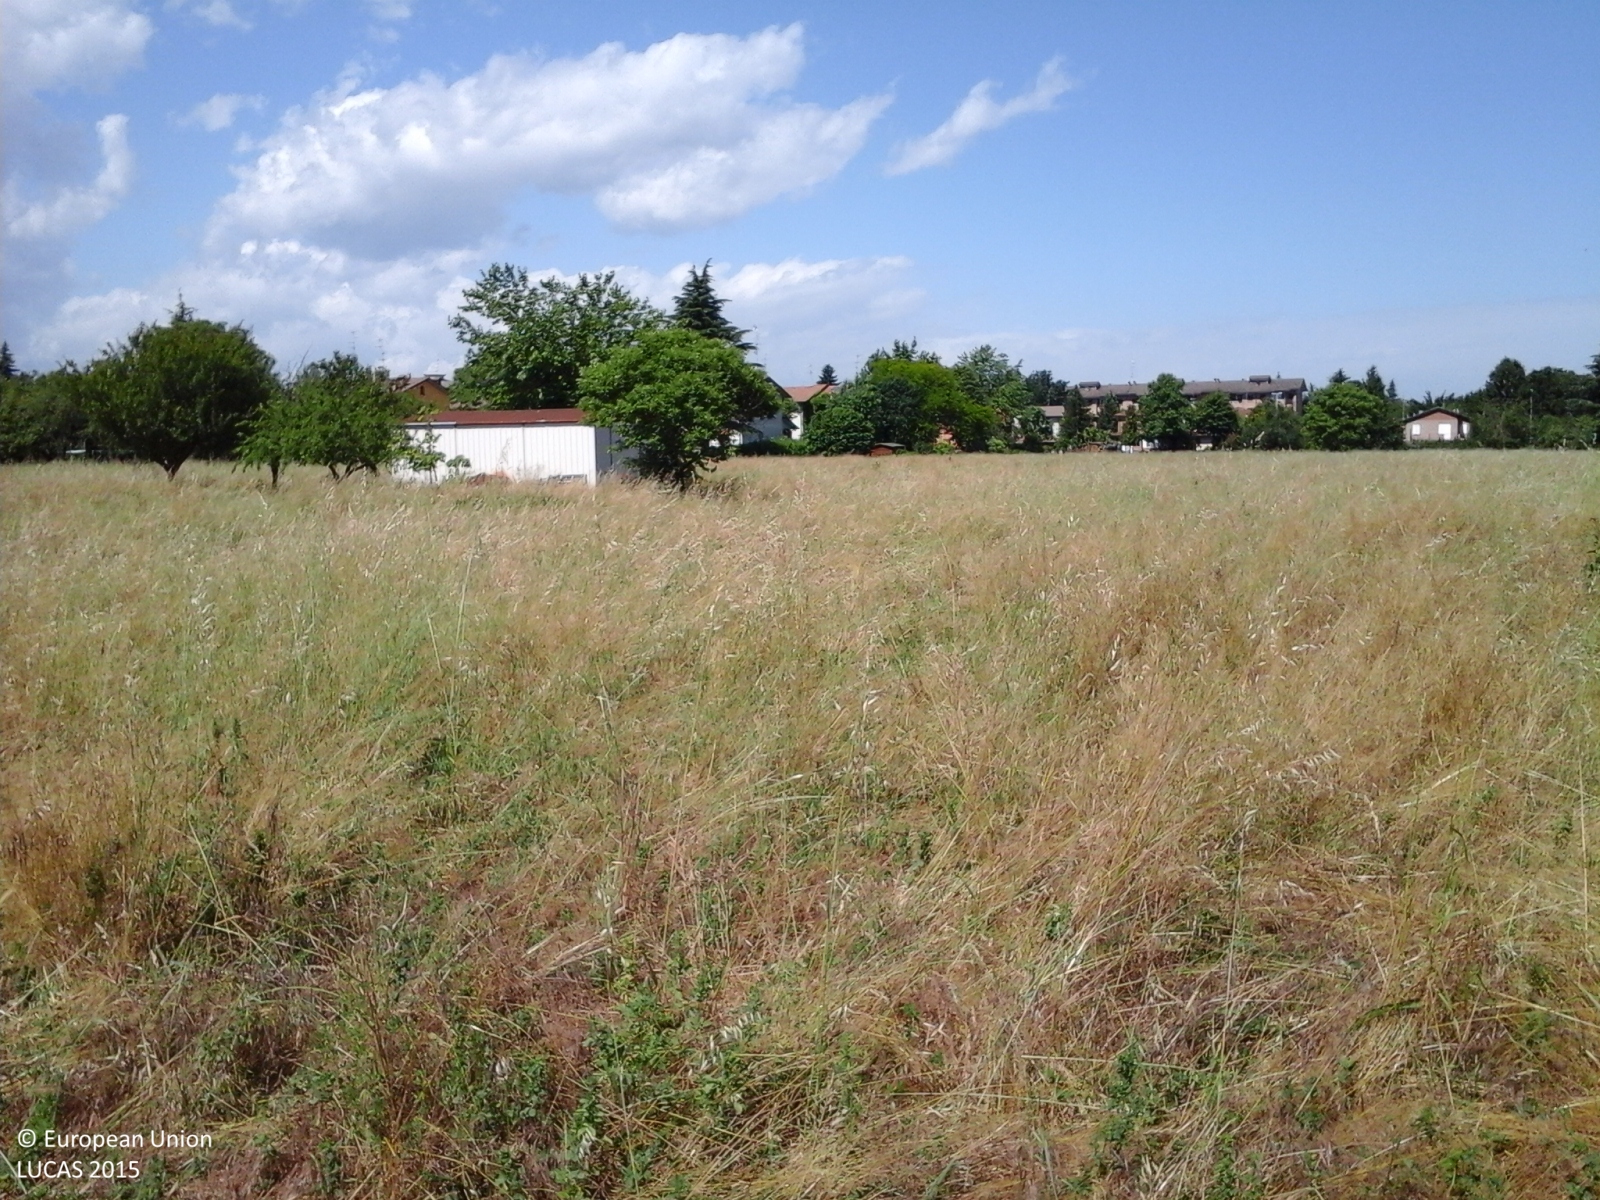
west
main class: Grassland
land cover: Spontaneously vegetated surfaces
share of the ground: > 75 %
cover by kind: herbaceous plants 100 %
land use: Agriculture (excluding fallow land and kitchen gardens)
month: May
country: IT
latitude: 44.6555
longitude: 10.5914
